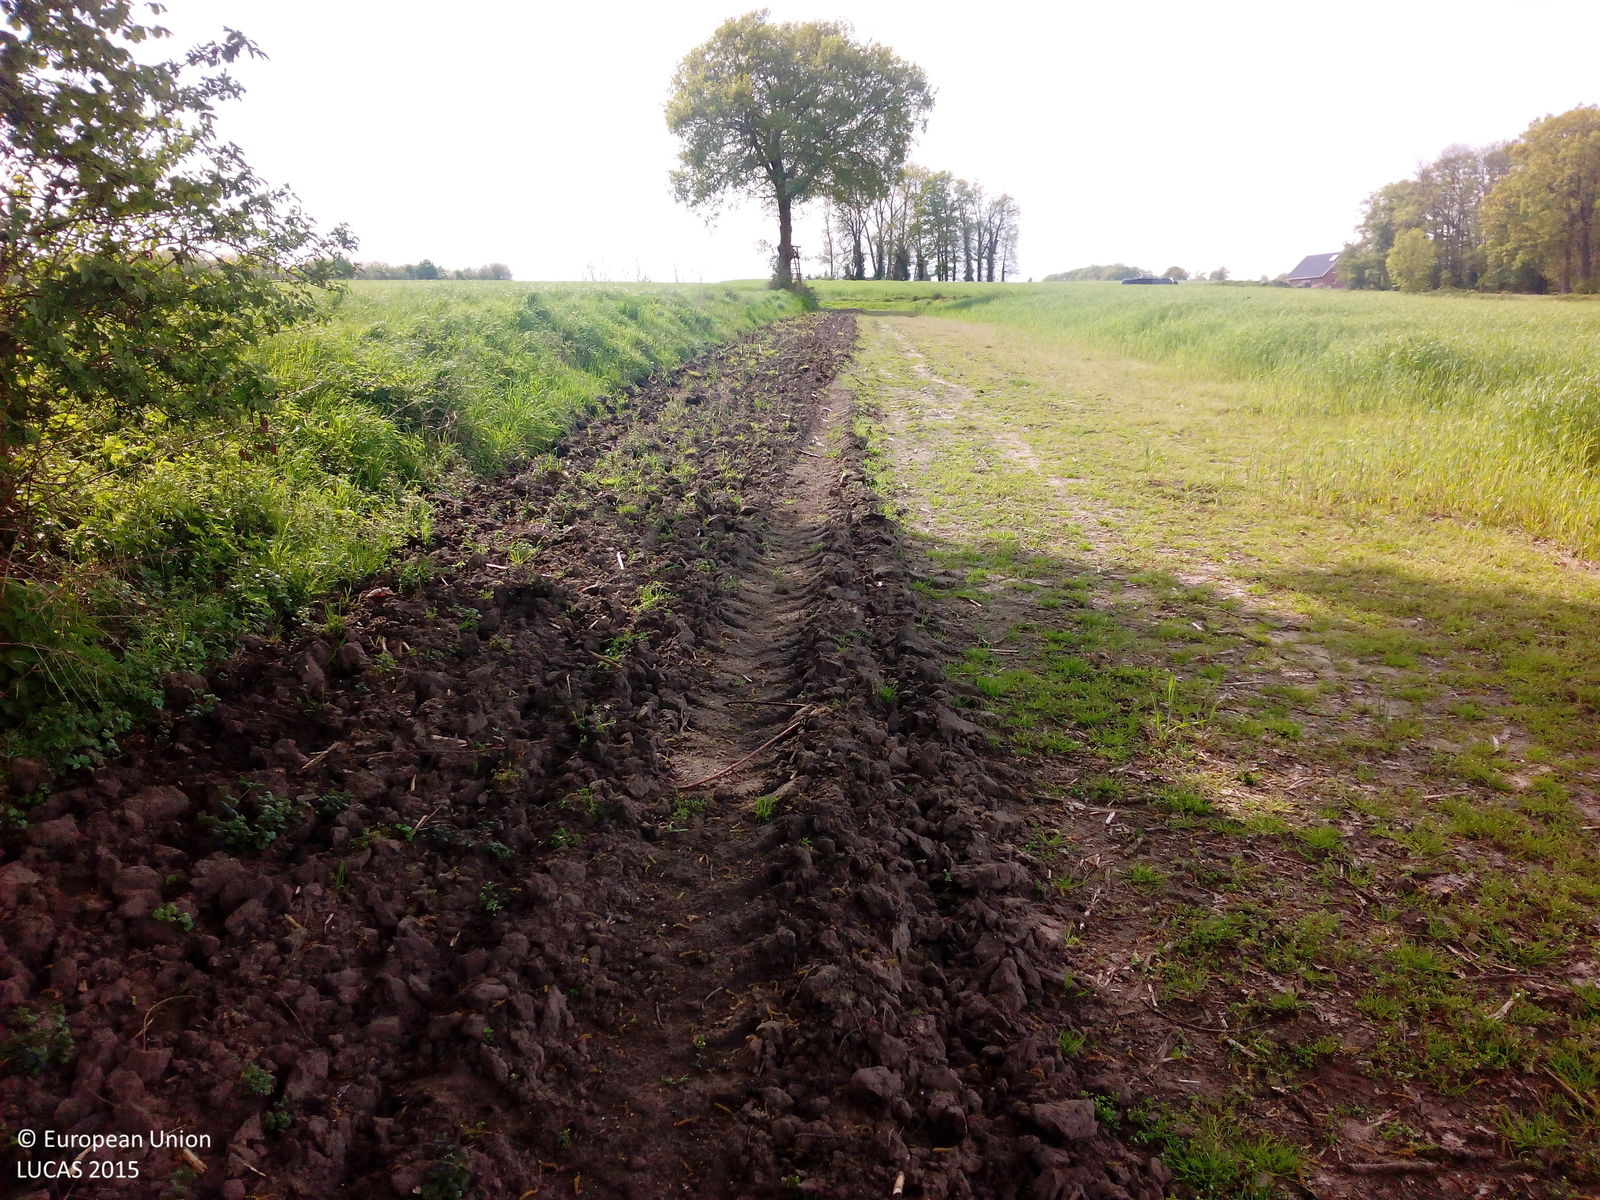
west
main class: Cropland
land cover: Maize
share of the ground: < 10 %
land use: Agriculture (excluding fallow land and kitchen gardens)
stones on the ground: < 10 %
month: May
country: DE
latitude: 52.1509
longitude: 7.3842
